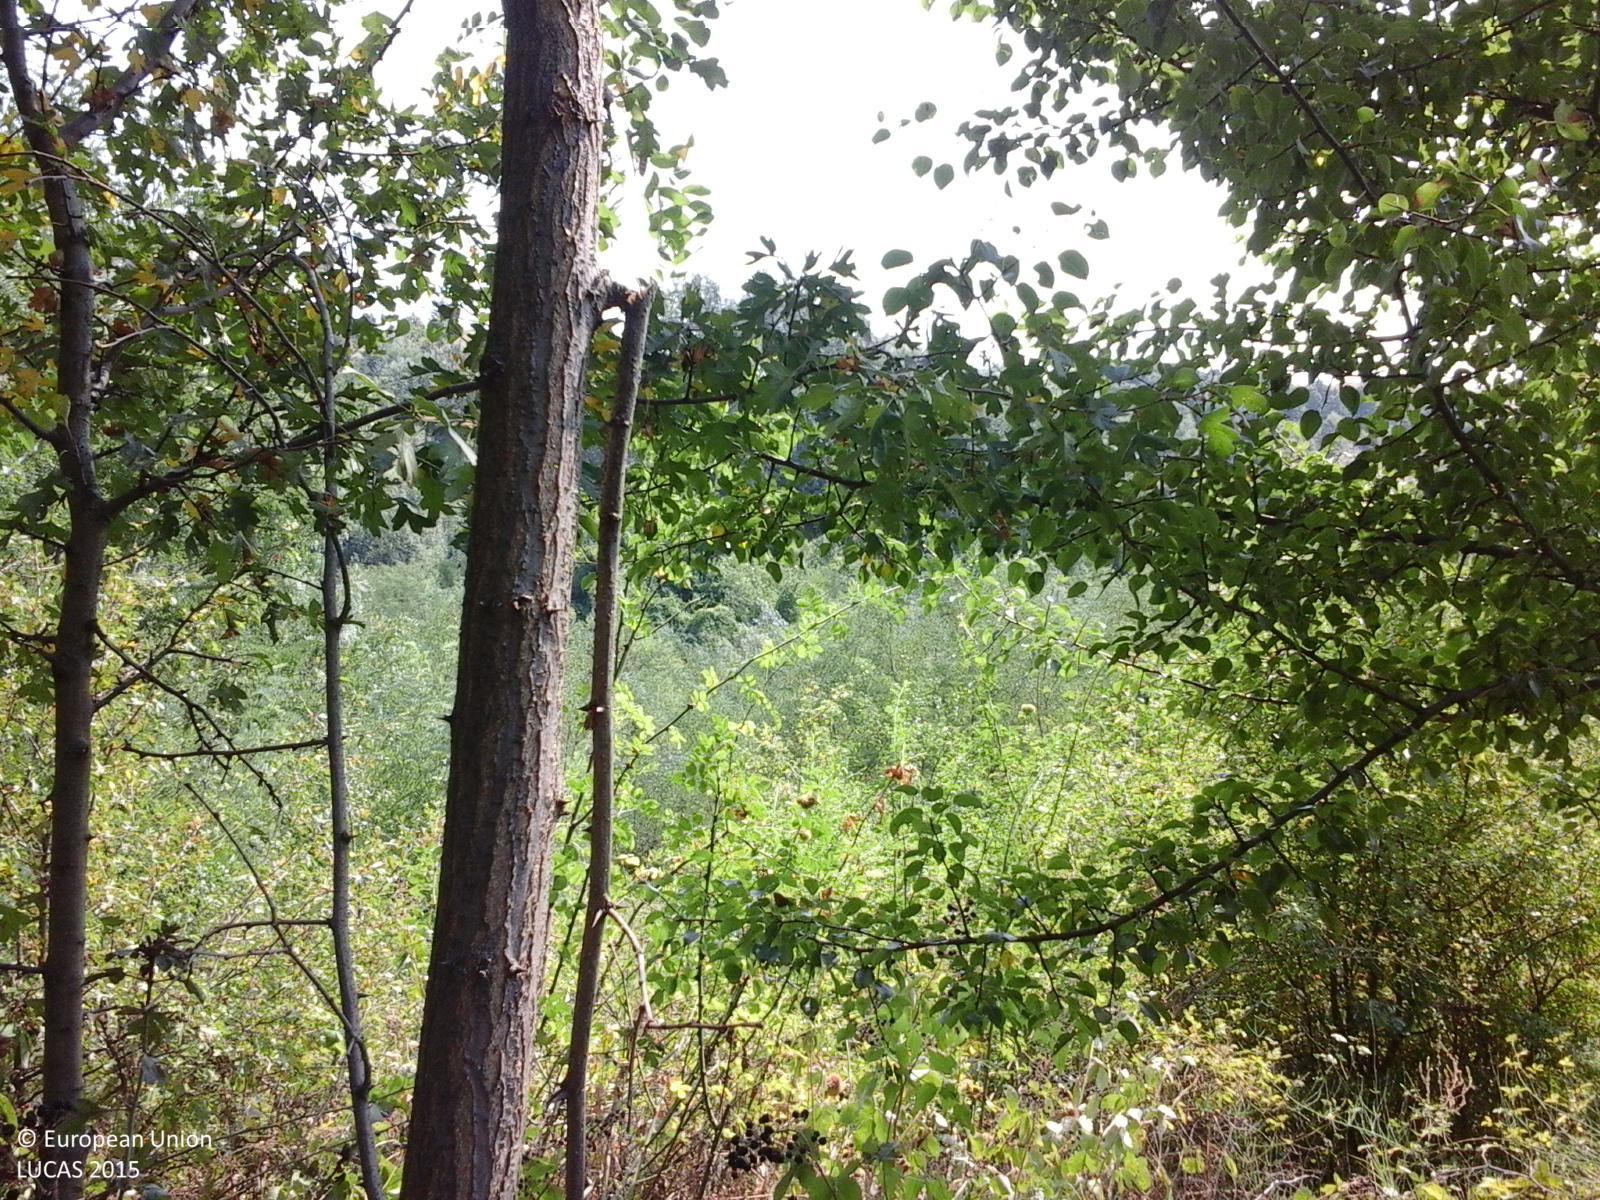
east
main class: Woodland
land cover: Broadleaved woodland
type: exotic forest
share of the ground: > 75 %
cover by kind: broadleaved forest trees 100 %
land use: Forestry
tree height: > 5 m
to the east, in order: Broadleaved woodland; Grassland with sparse tree/shrub cover; Broadleaved woodland; Grassland with sparse tree/shrub cover
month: August
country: RO
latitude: 44.5211
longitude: 23.3753
